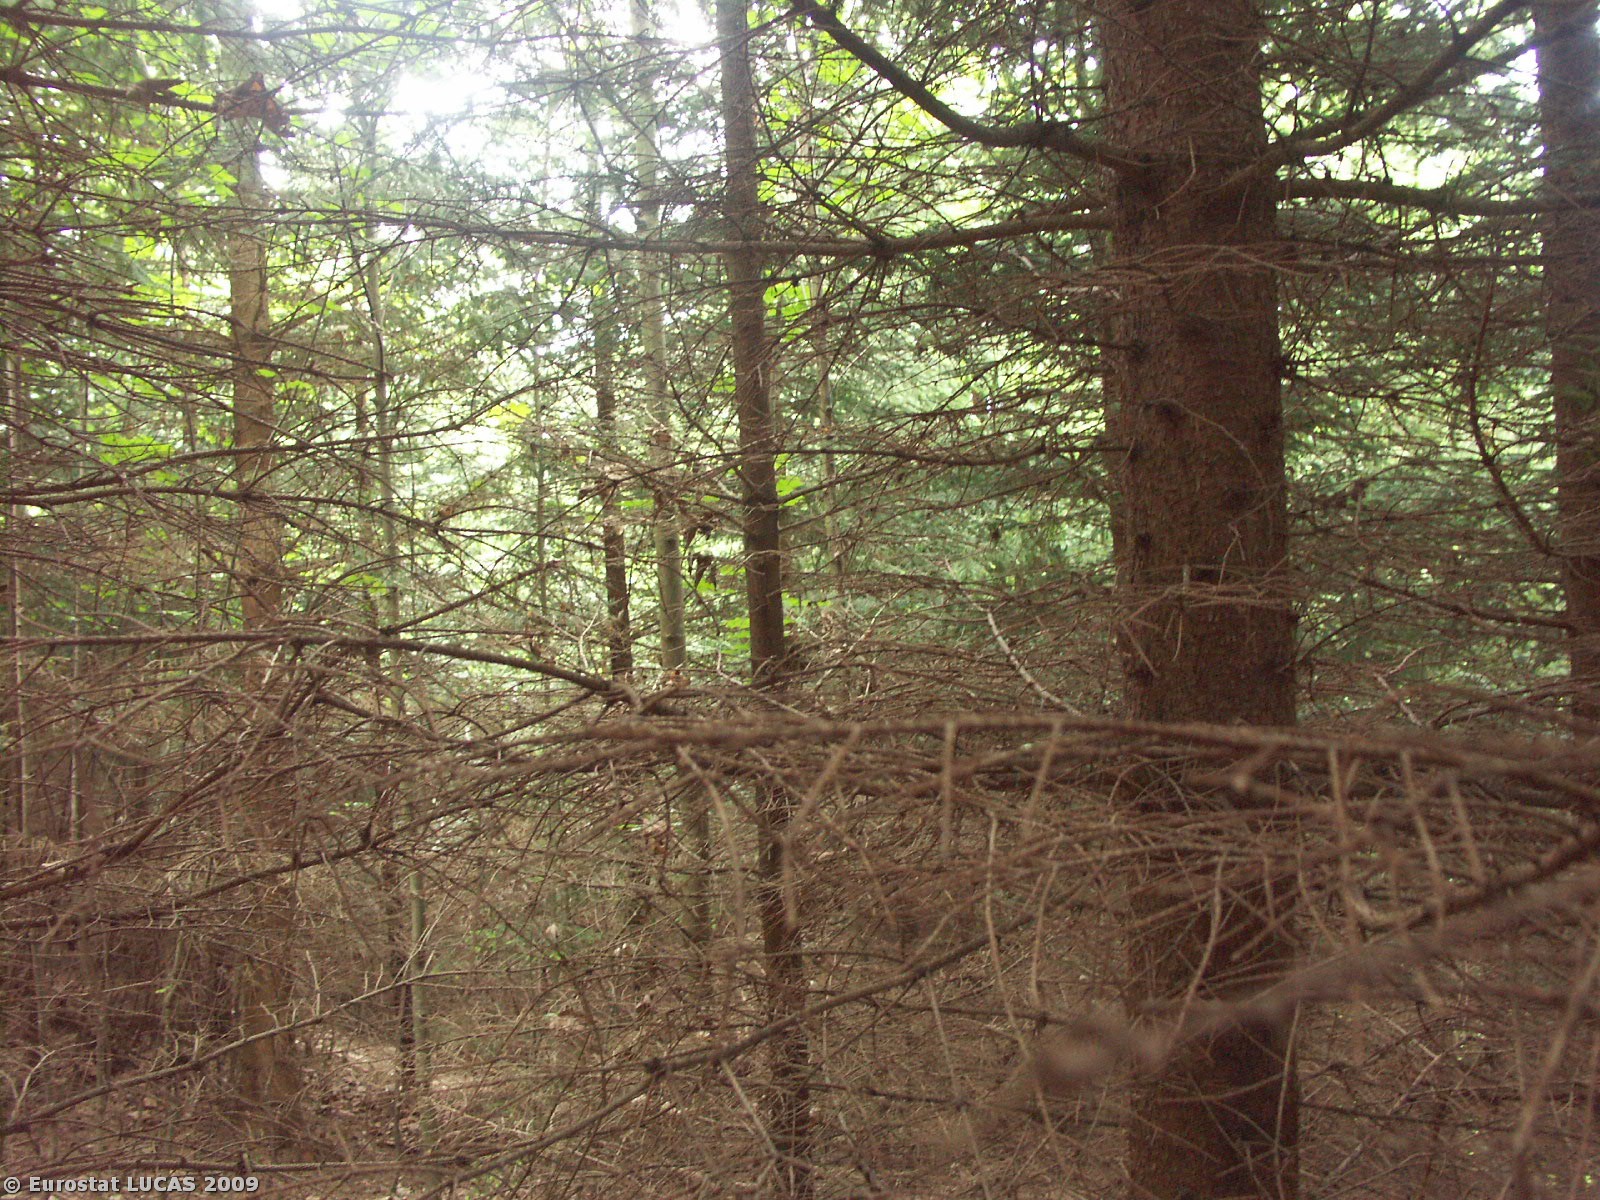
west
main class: Woodland
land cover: Coniferous woodland
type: hemiboreal forest and nemoral coniferous forest and mixed broadleaved-coniferous forest
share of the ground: > 75 %
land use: Forestry
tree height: > 5 m
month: May
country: CZ
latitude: 48.6860
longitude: 14.6059
